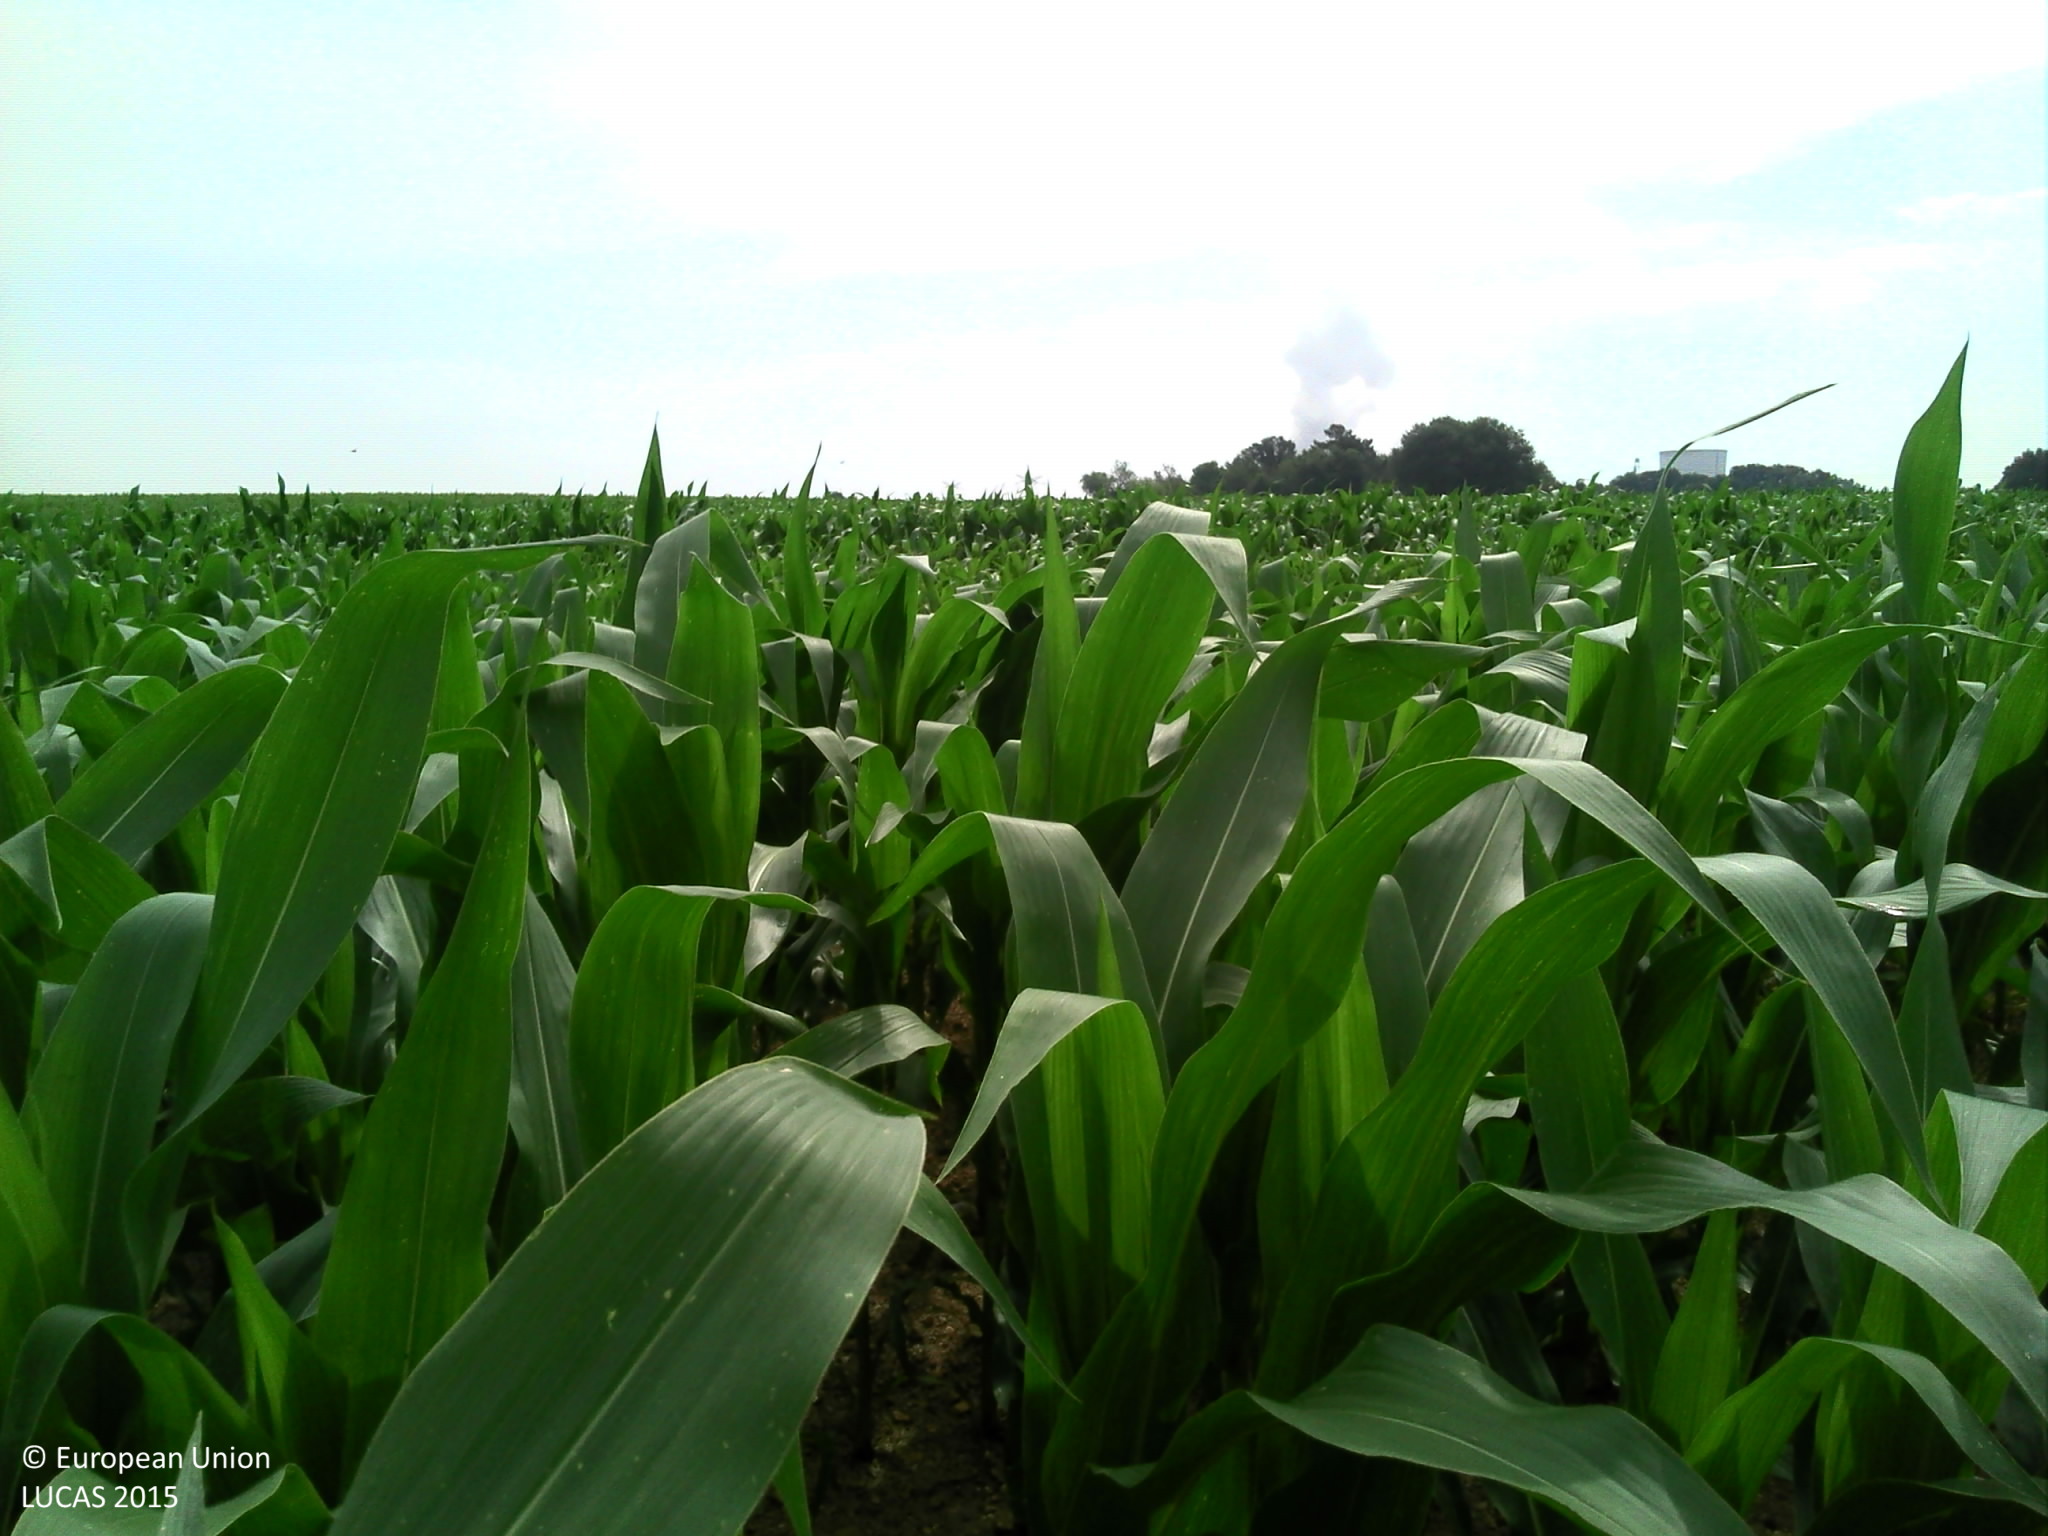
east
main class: Grassland
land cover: Grassland without tree/shrub cover
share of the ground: > 75 %
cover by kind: herbaceous plants 100 %
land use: Residential
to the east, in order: Grassland without tree/shrub cover; Artificial constructions in urban areas; Maize; Sunflower
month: July
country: FR
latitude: 46.4640
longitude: 0.6211
